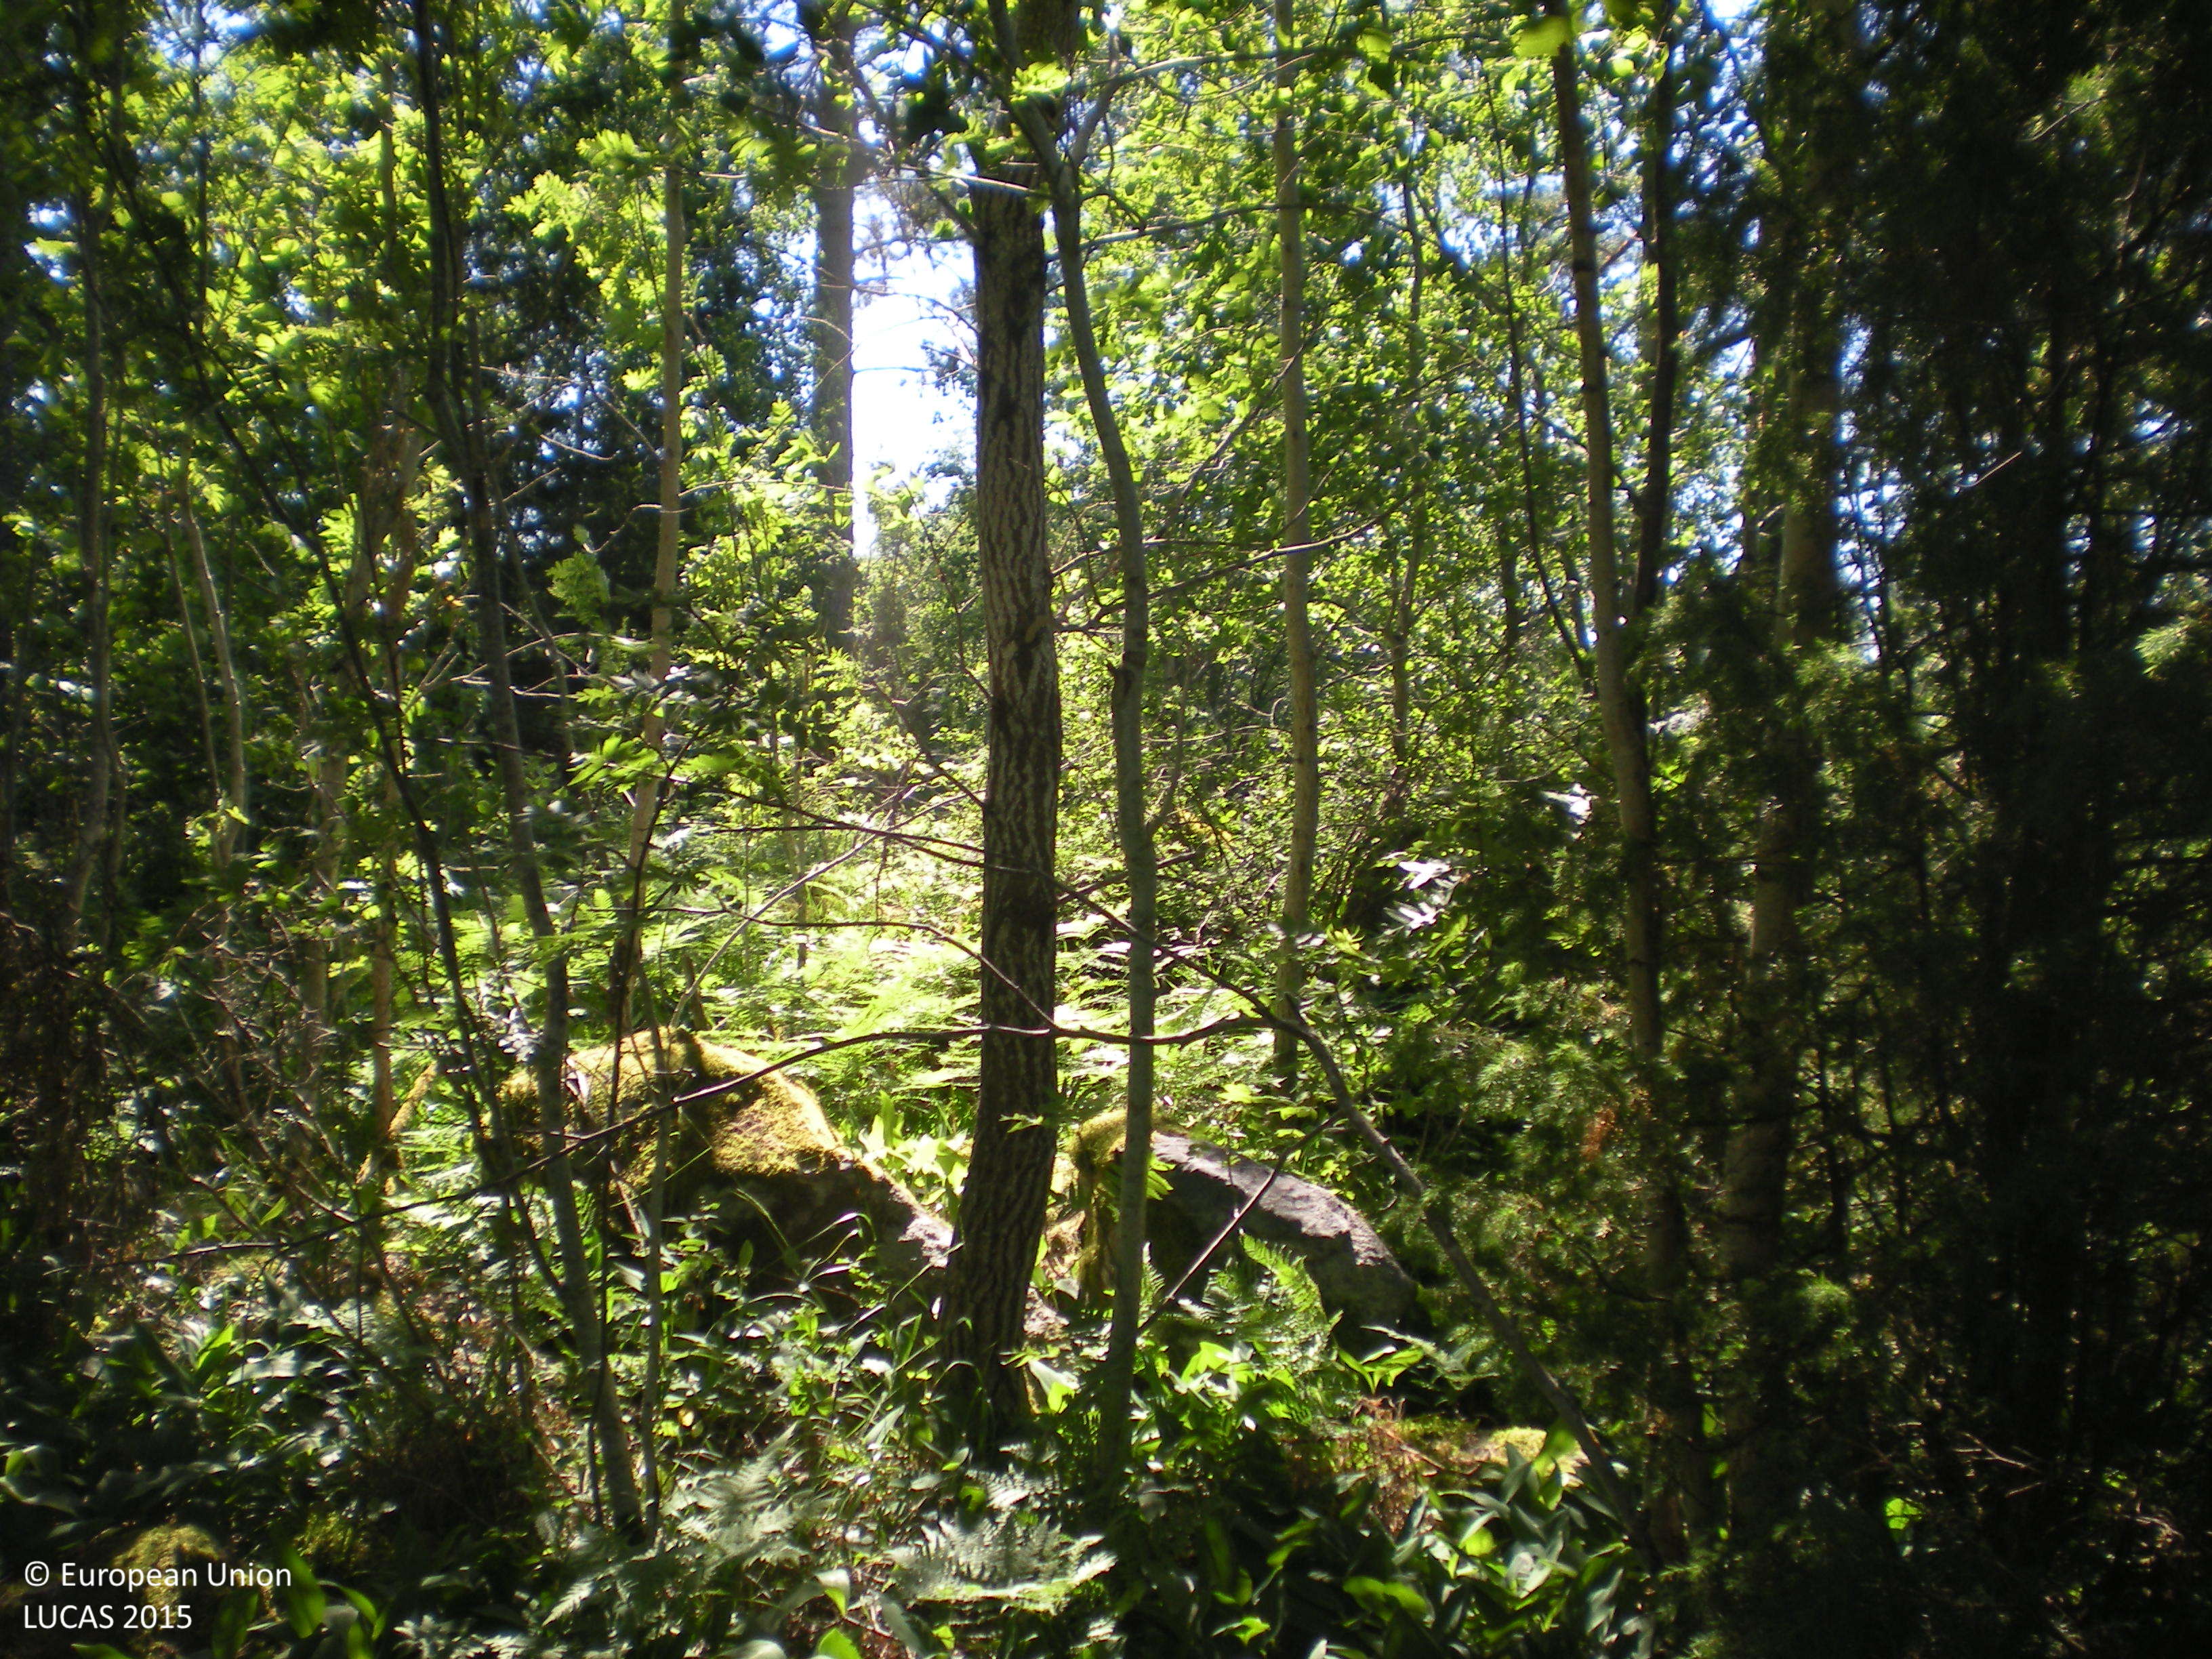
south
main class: Woodland
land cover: Broadleaved woodland
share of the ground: 50 - 75 %
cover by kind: broadleaved forest trees 45 %, herbaceous plants 40 %, shrubs 10 %, coniferous forest trees 5 %
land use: Semi-natural and natural areas not in use
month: July
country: SE
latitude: 60.4559
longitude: 17.7552
